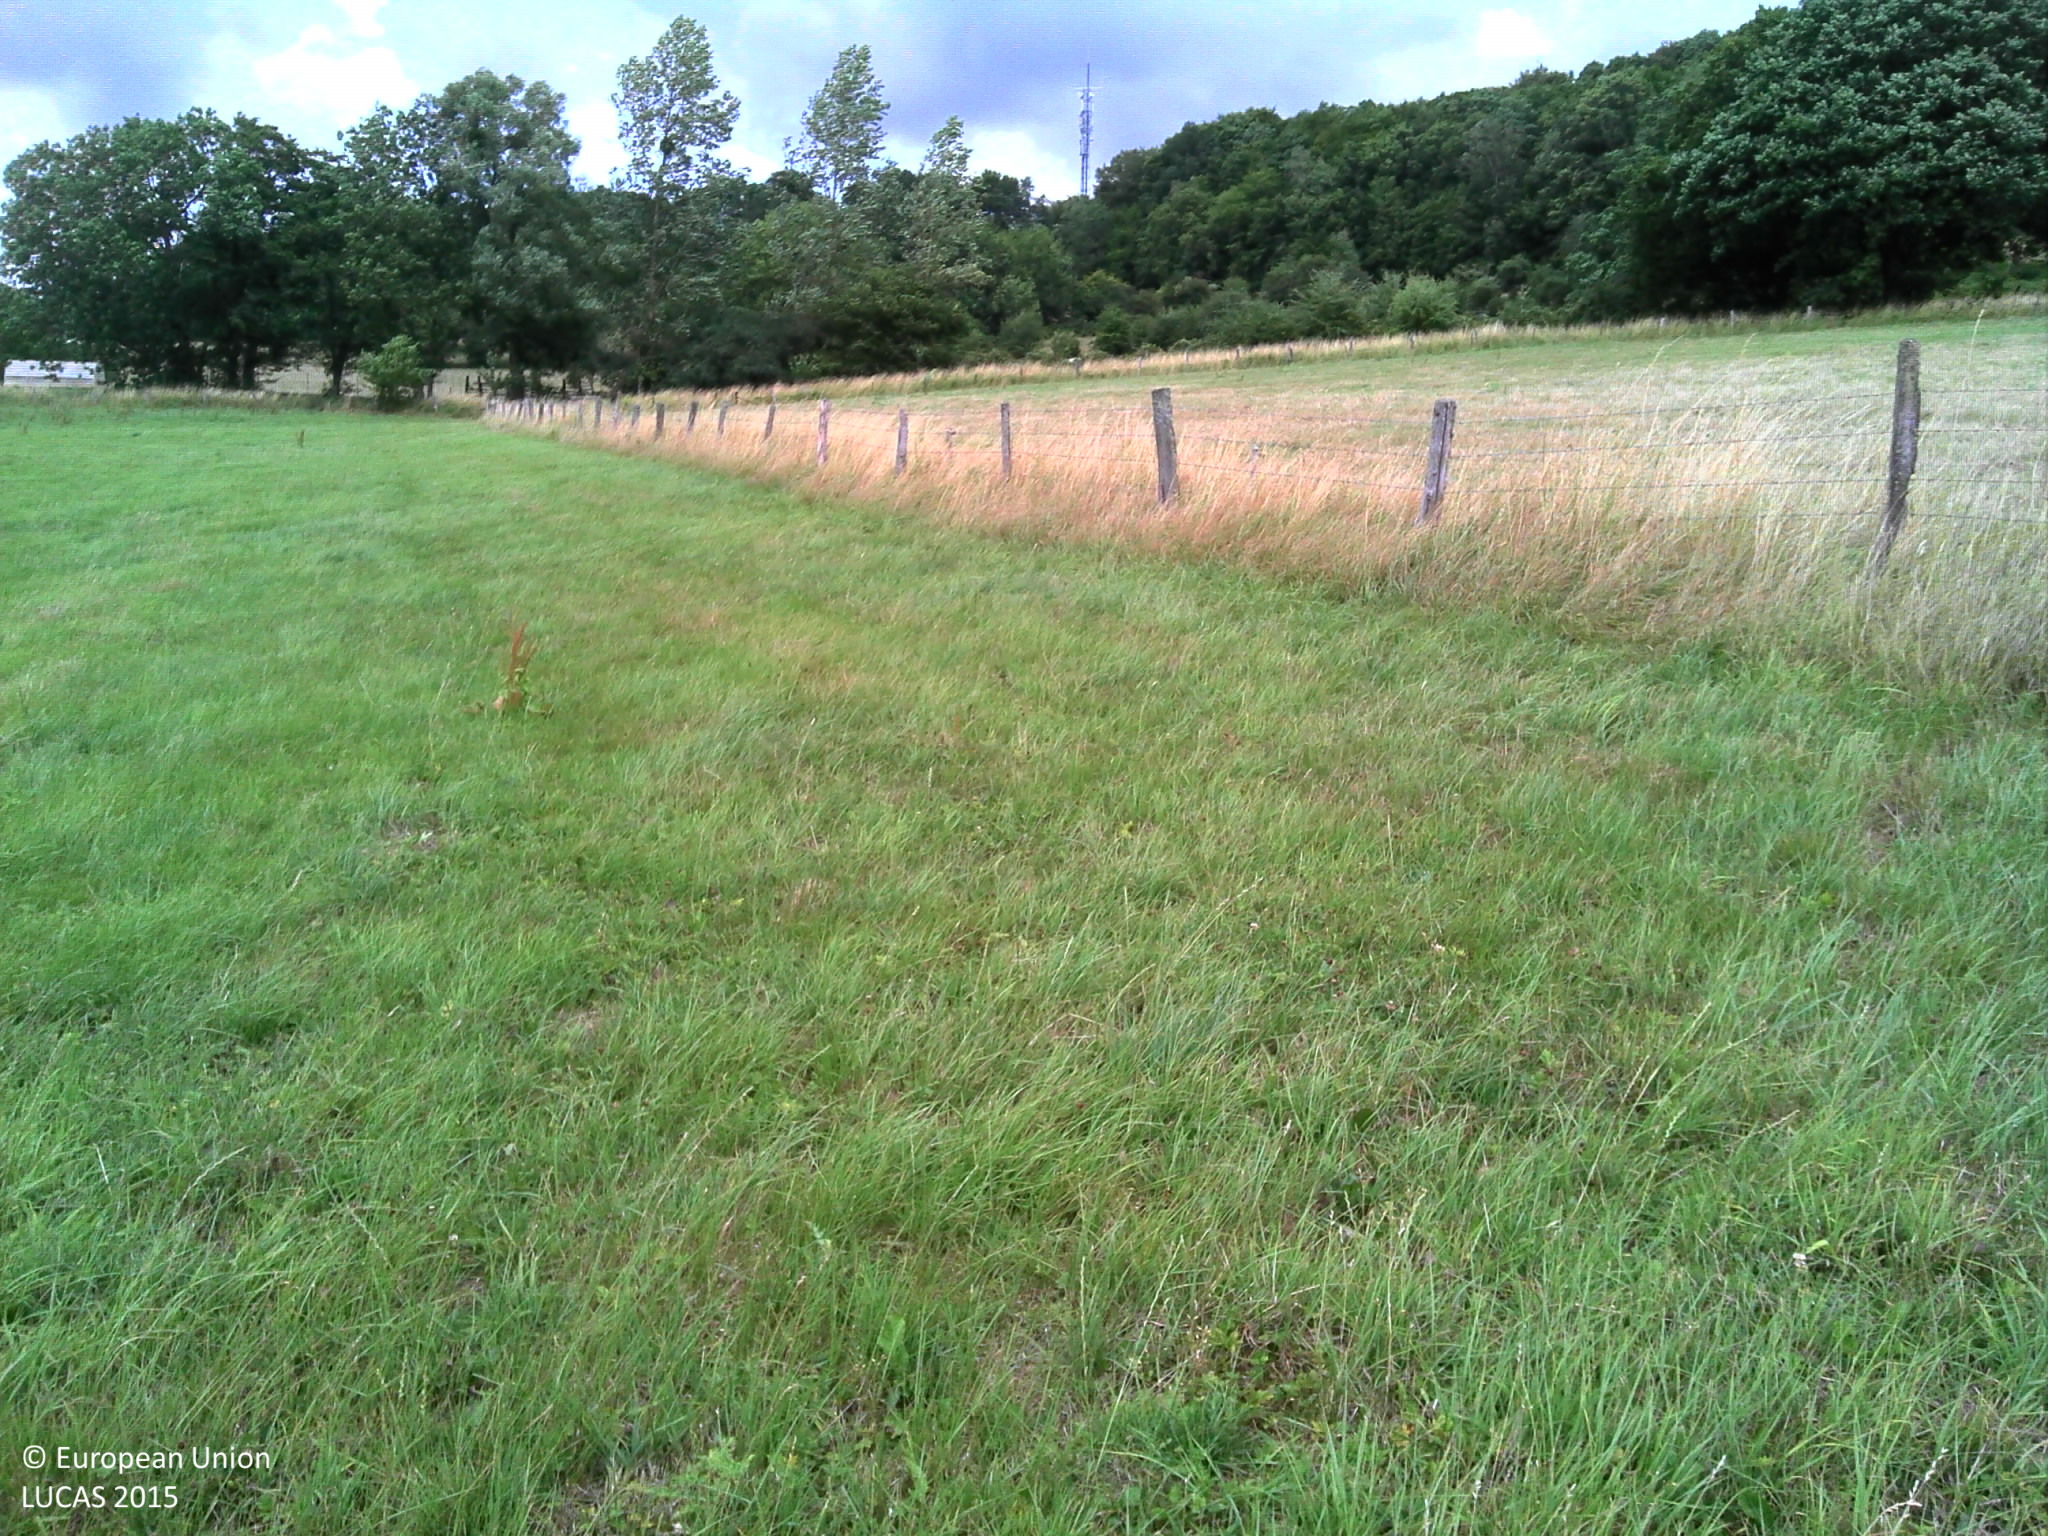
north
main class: Grassland
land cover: Grassland without tree/shrub cover
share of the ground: > 75 %
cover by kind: herbaceous plants 100 %
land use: Agriculture (excluding fallow land and kitchen gardens)
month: July
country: BE
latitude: 49.5977
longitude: 5.6682
